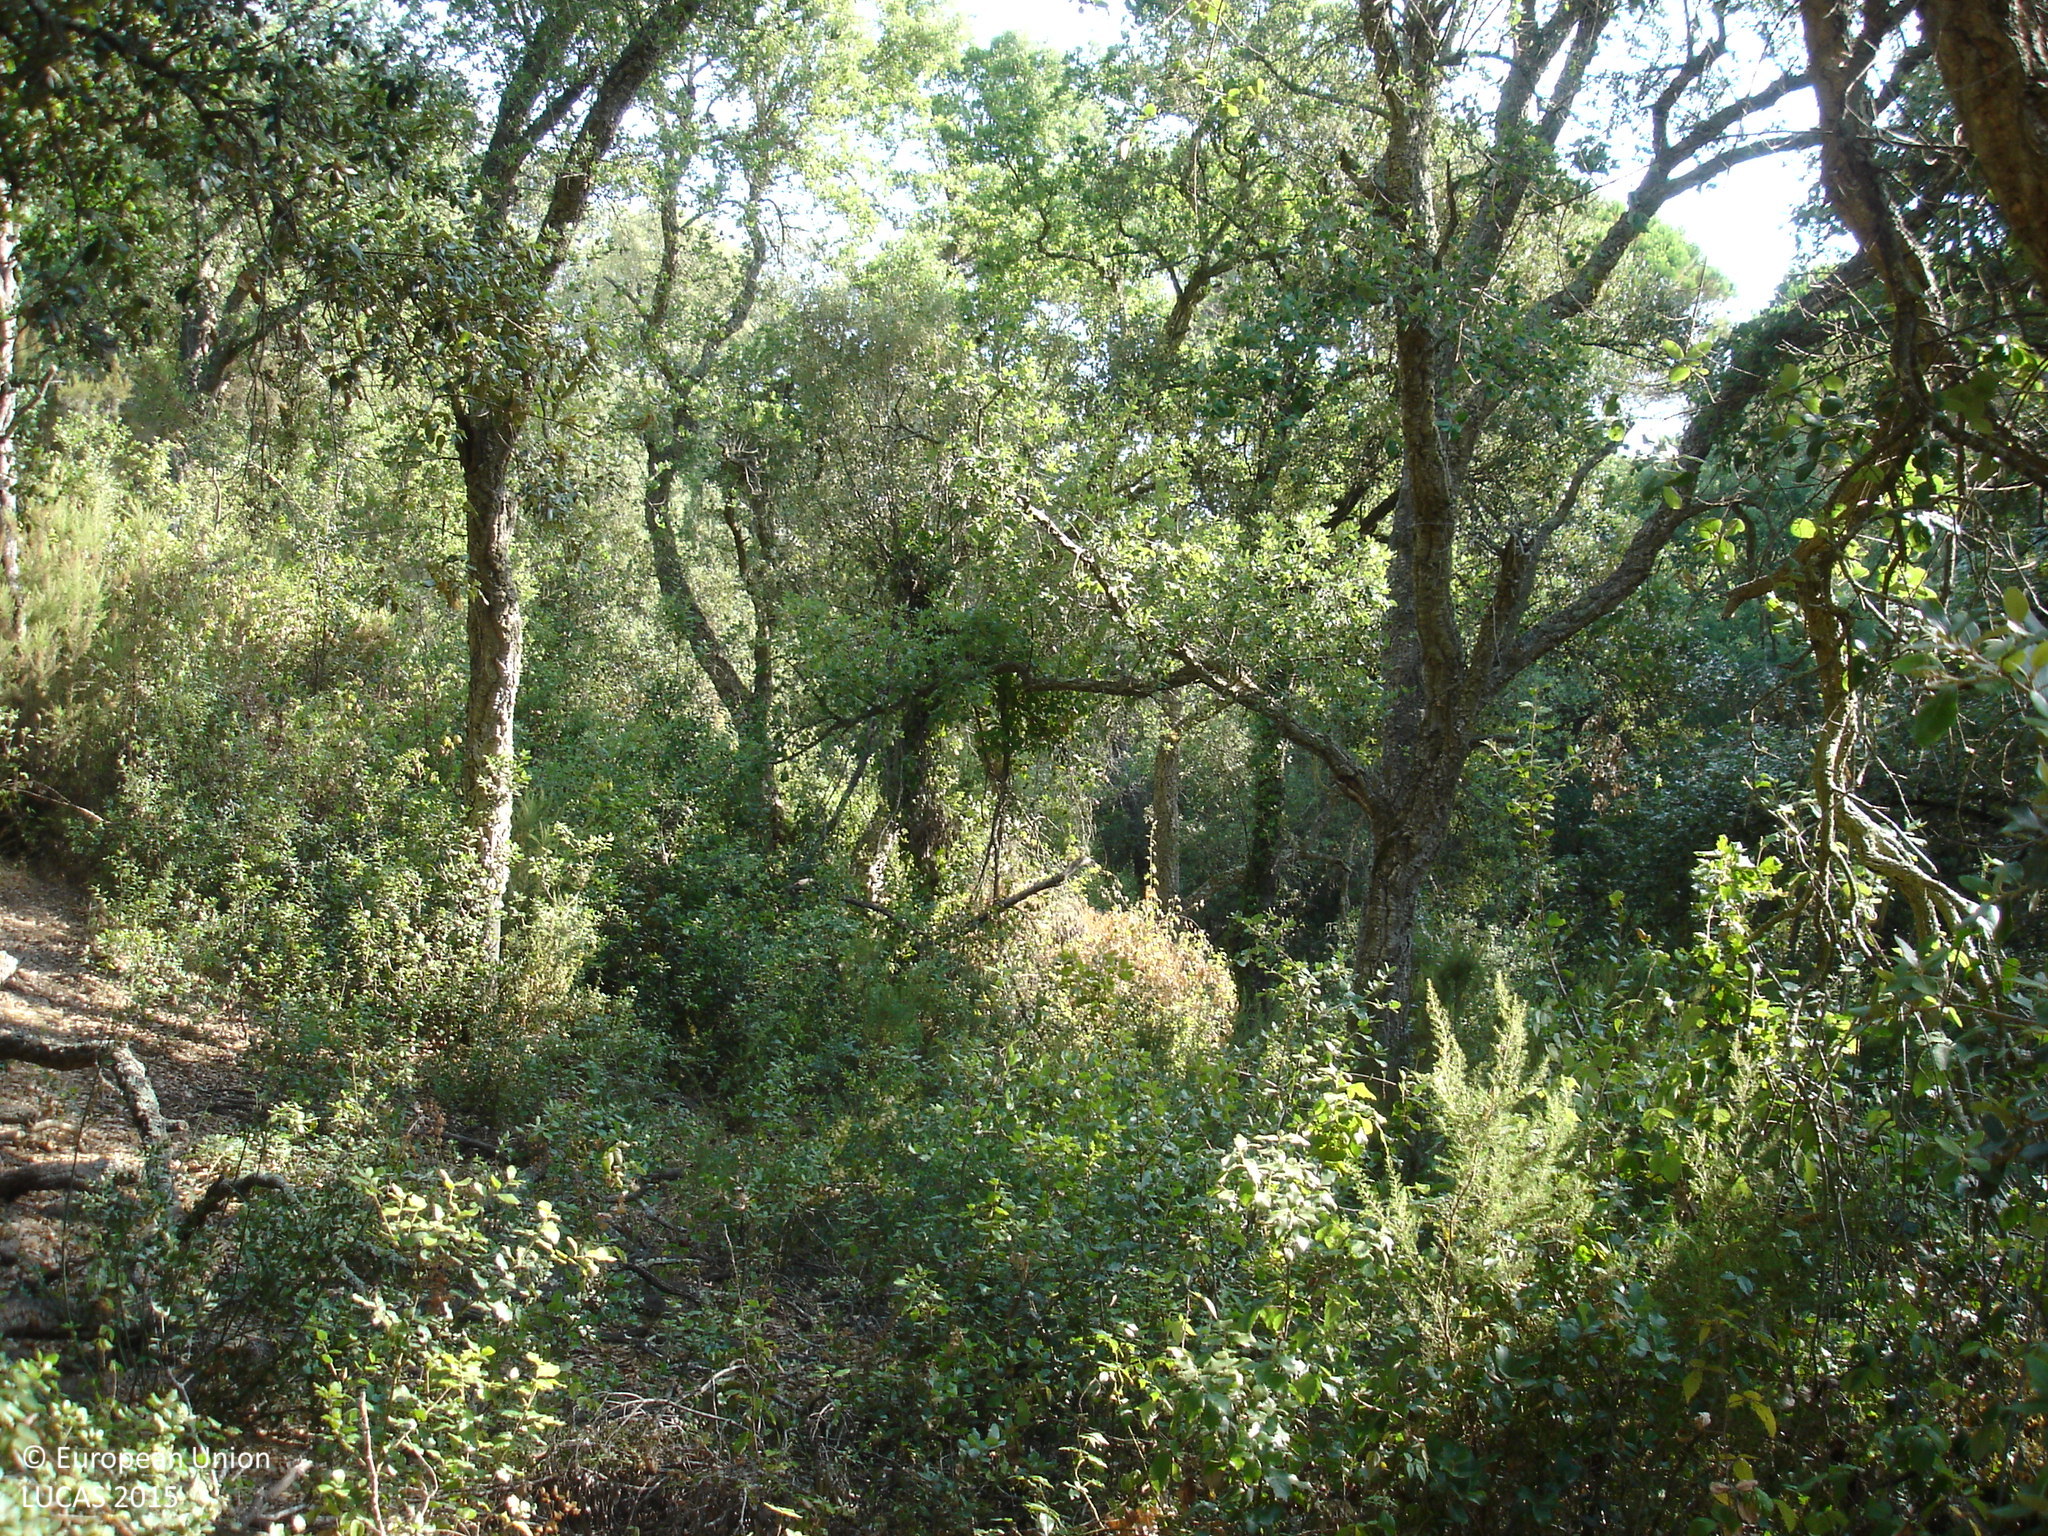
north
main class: Woodland
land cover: Other mixed woodland
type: thermophilous deciduous forest
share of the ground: > 75 %
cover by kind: broadleaved forest trees 60 %, coniferous forest trees 20 %, shrubs 15 %, herbaceous plants 5 %
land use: Forestry
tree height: > 5 m
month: July
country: ES
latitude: 41.9476
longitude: 3.1040
